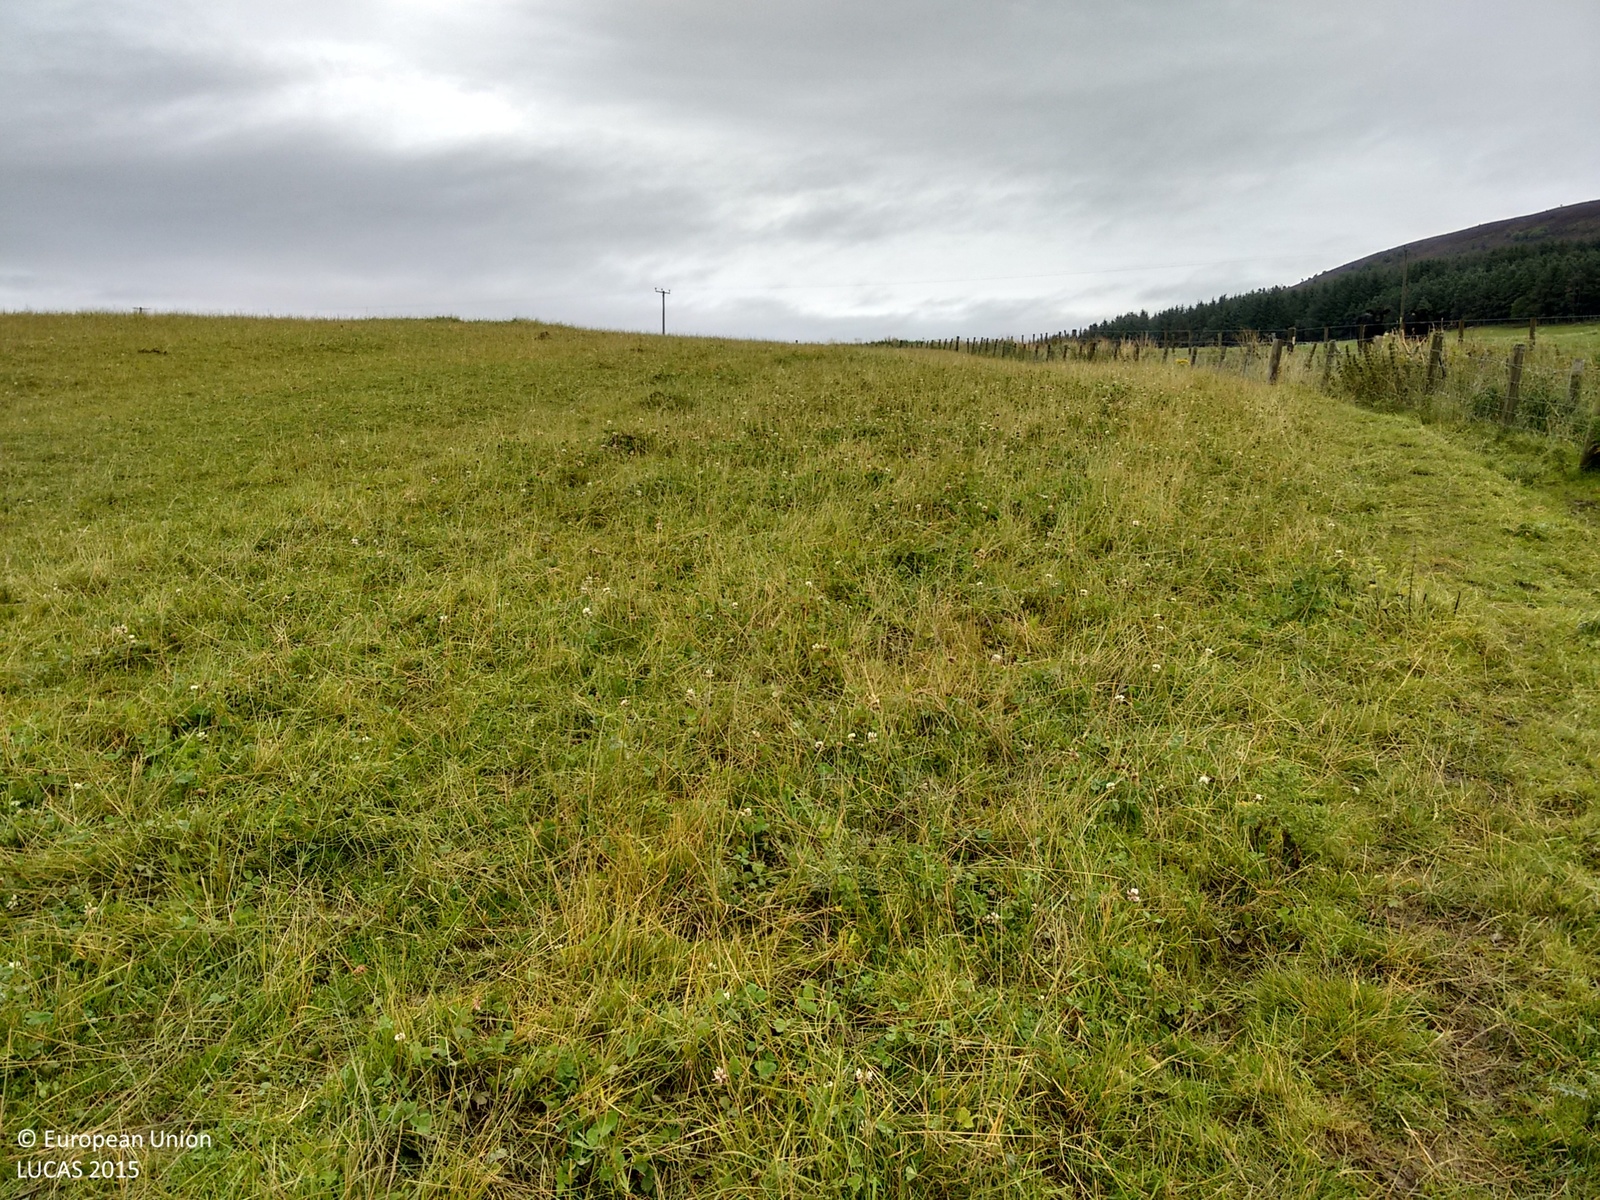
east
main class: Grassland
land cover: Grassland without tree/shrub cover
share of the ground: > 75 %
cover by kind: herbaceous plants 95 %, unconsolidated bare surface 5 %
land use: Agriculture (excluding fallow land and kitchen gardens)
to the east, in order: Grassland without tree/shrub cover; Fences; Shruby margins; Tracks; Shruby margins; Fences; Grassland without tree/shrub cover; Electric lines; Grassland without tree/shrub cover
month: September
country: GB
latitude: 57.5391
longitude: -2.9055
